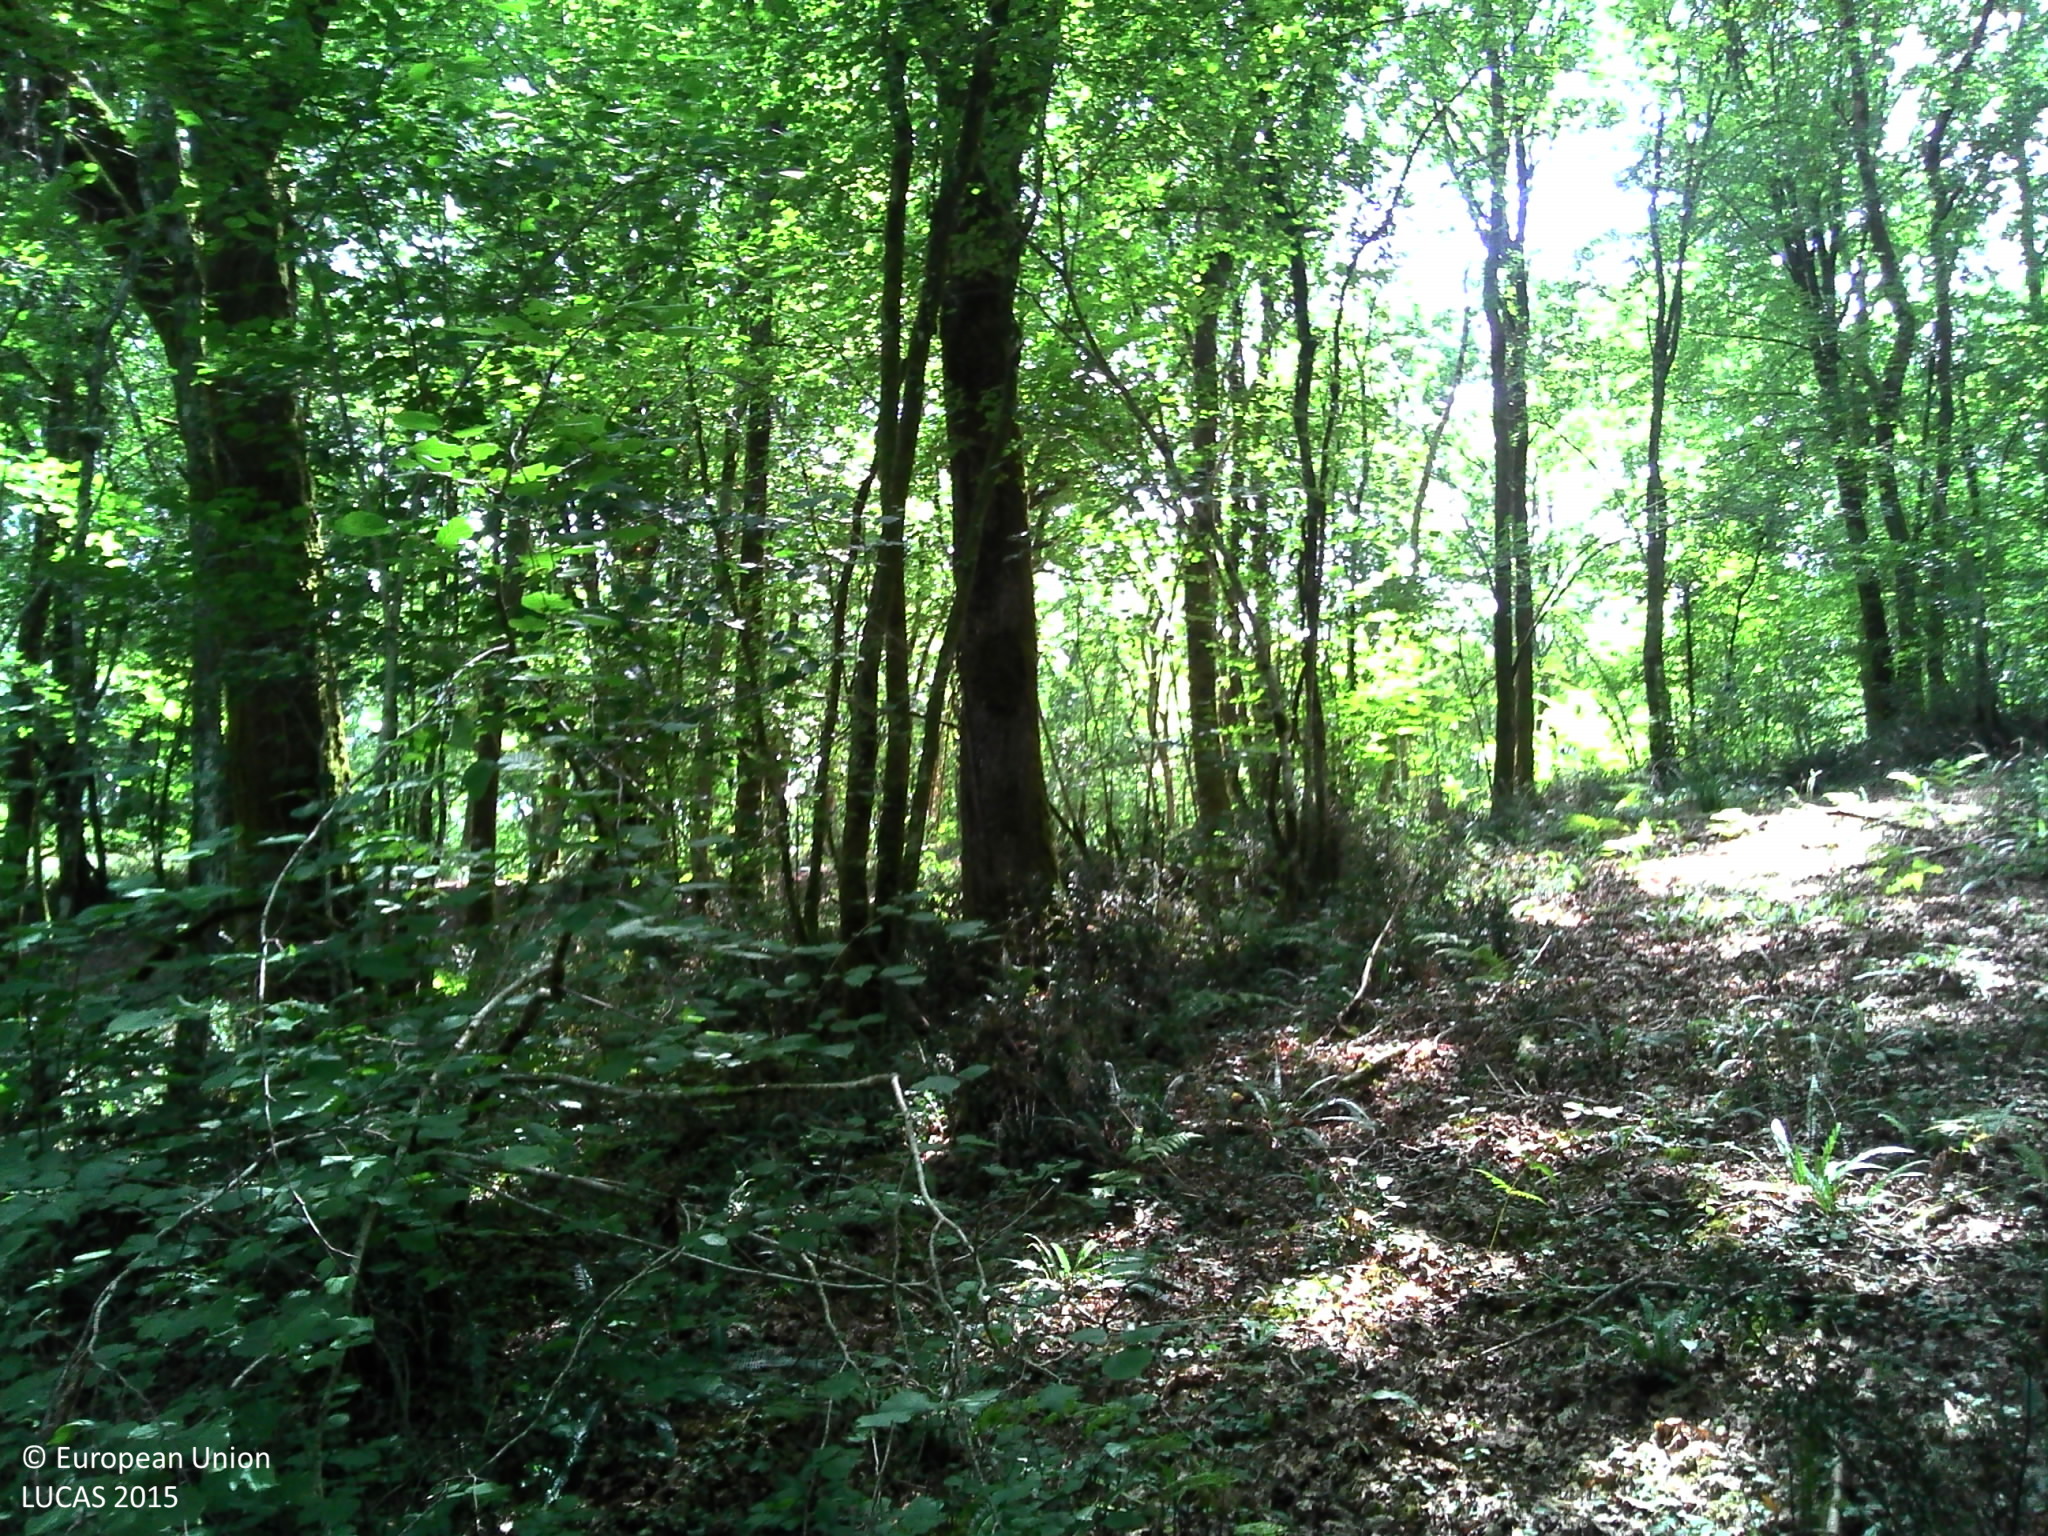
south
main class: Woodland
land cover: Broadleaved woodland
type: beech forest
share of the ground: > 75 %
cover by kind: broadleaved forest trees 70 %, shrubs 10 %, herbaceous plants 10 %, lichens and mosses 10 %
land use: Forestry
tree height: > 5 m
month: August
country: FR
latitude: 43.4679
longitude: -1.3768
